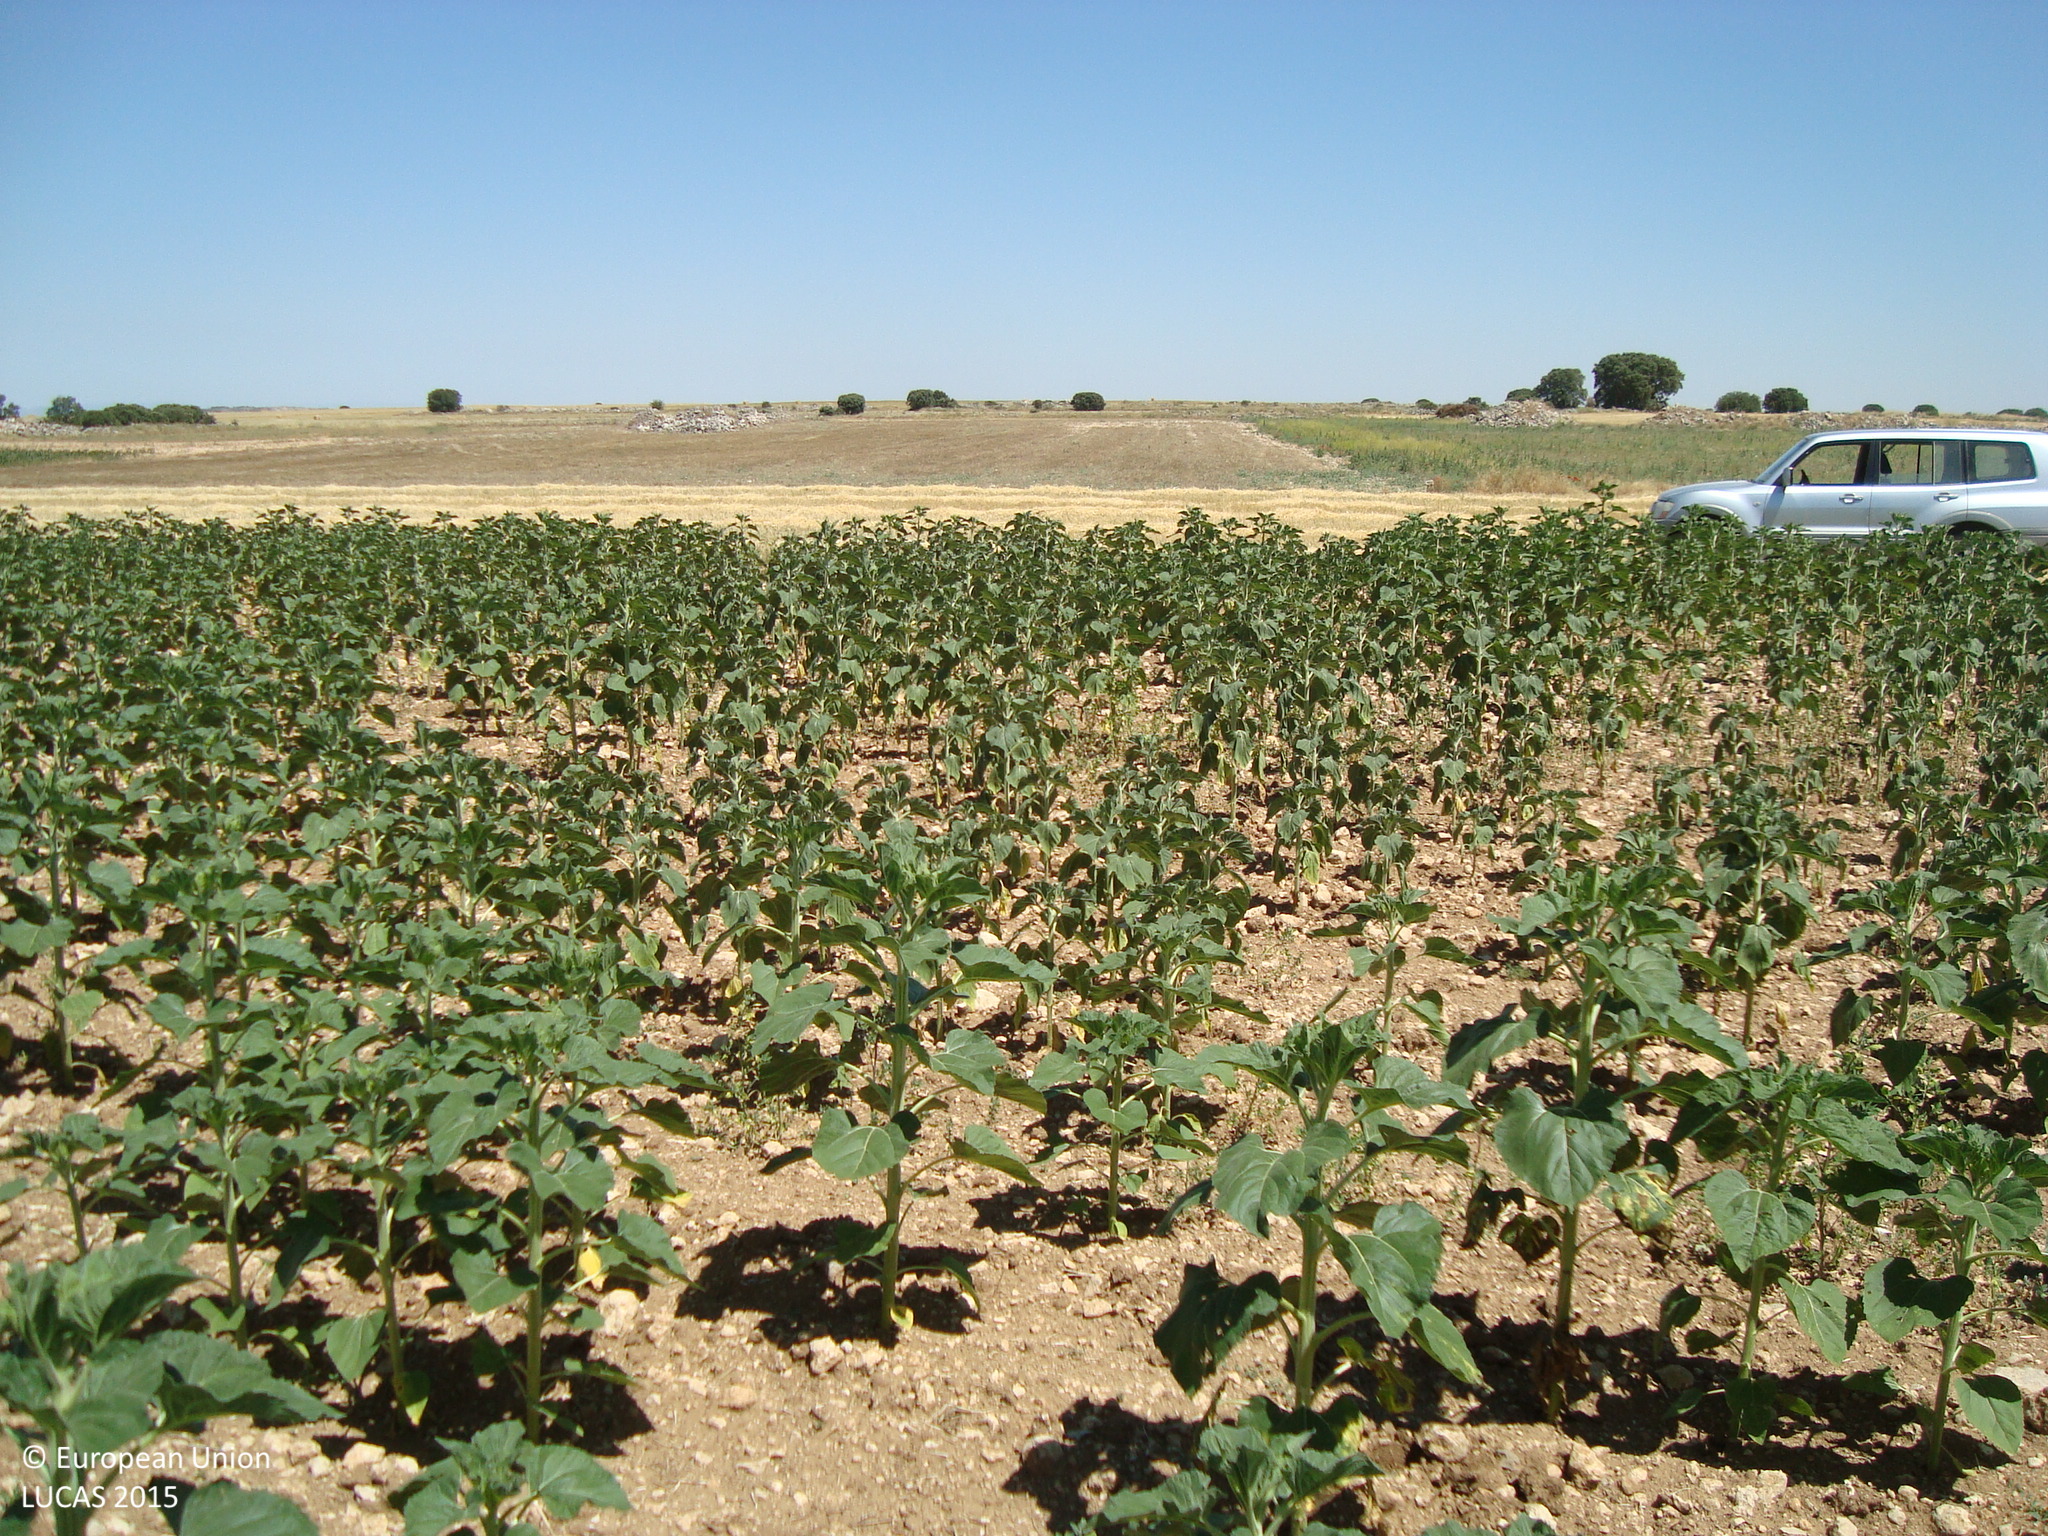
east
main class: Cropland
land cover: Sunflower
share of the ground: > 75 %
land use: Agriculture (excluding fallow land and kitchen gardens)
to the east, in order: Sunflower; Barley; Spontaneously vegetated surfaces; Grass margins; Tracks; Grass margins; Dry stone walls; Spontaneously vegetated surfaces
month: July
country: ES
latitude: 41.7079
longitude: -4.0353
